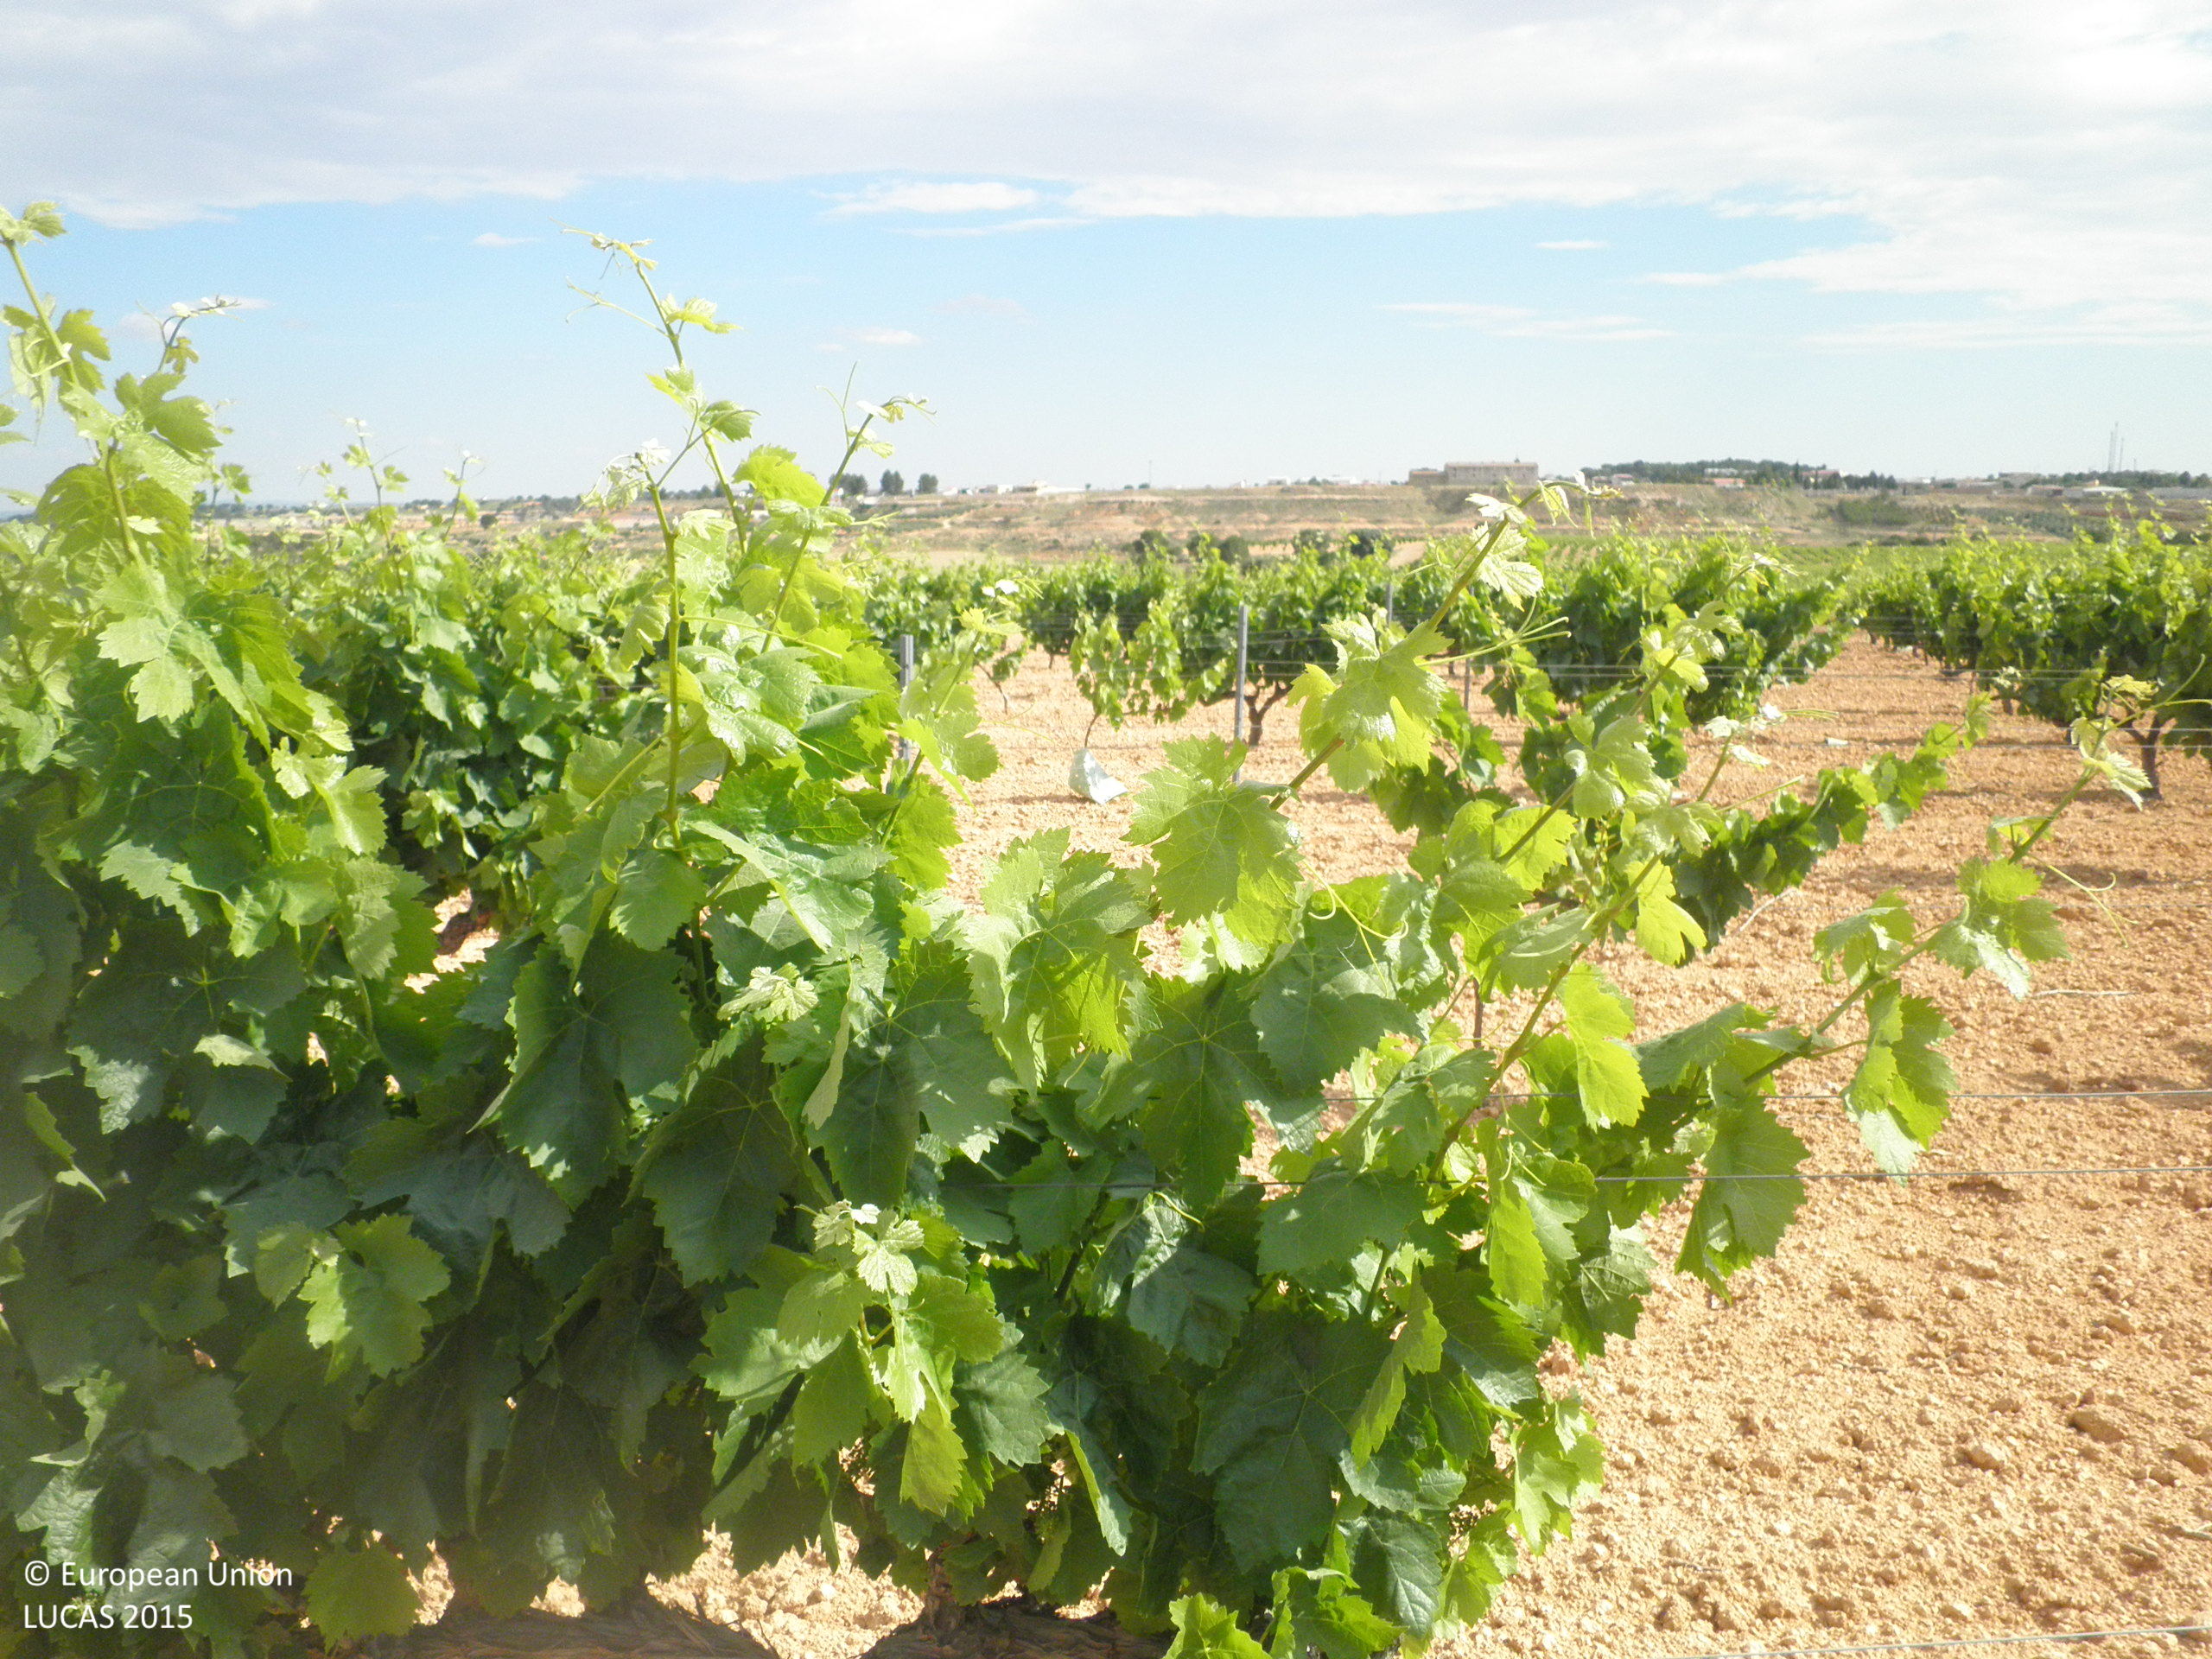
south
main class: Cropland
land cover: Vineyards
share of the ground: < 10 %
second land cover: Other bare soil
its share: > 75 %
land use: Agriculture (excluding fallow land and kitchen gardens)
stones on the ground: < 10 %
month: June
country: ES
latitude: 39.3139
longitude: -1.6590
